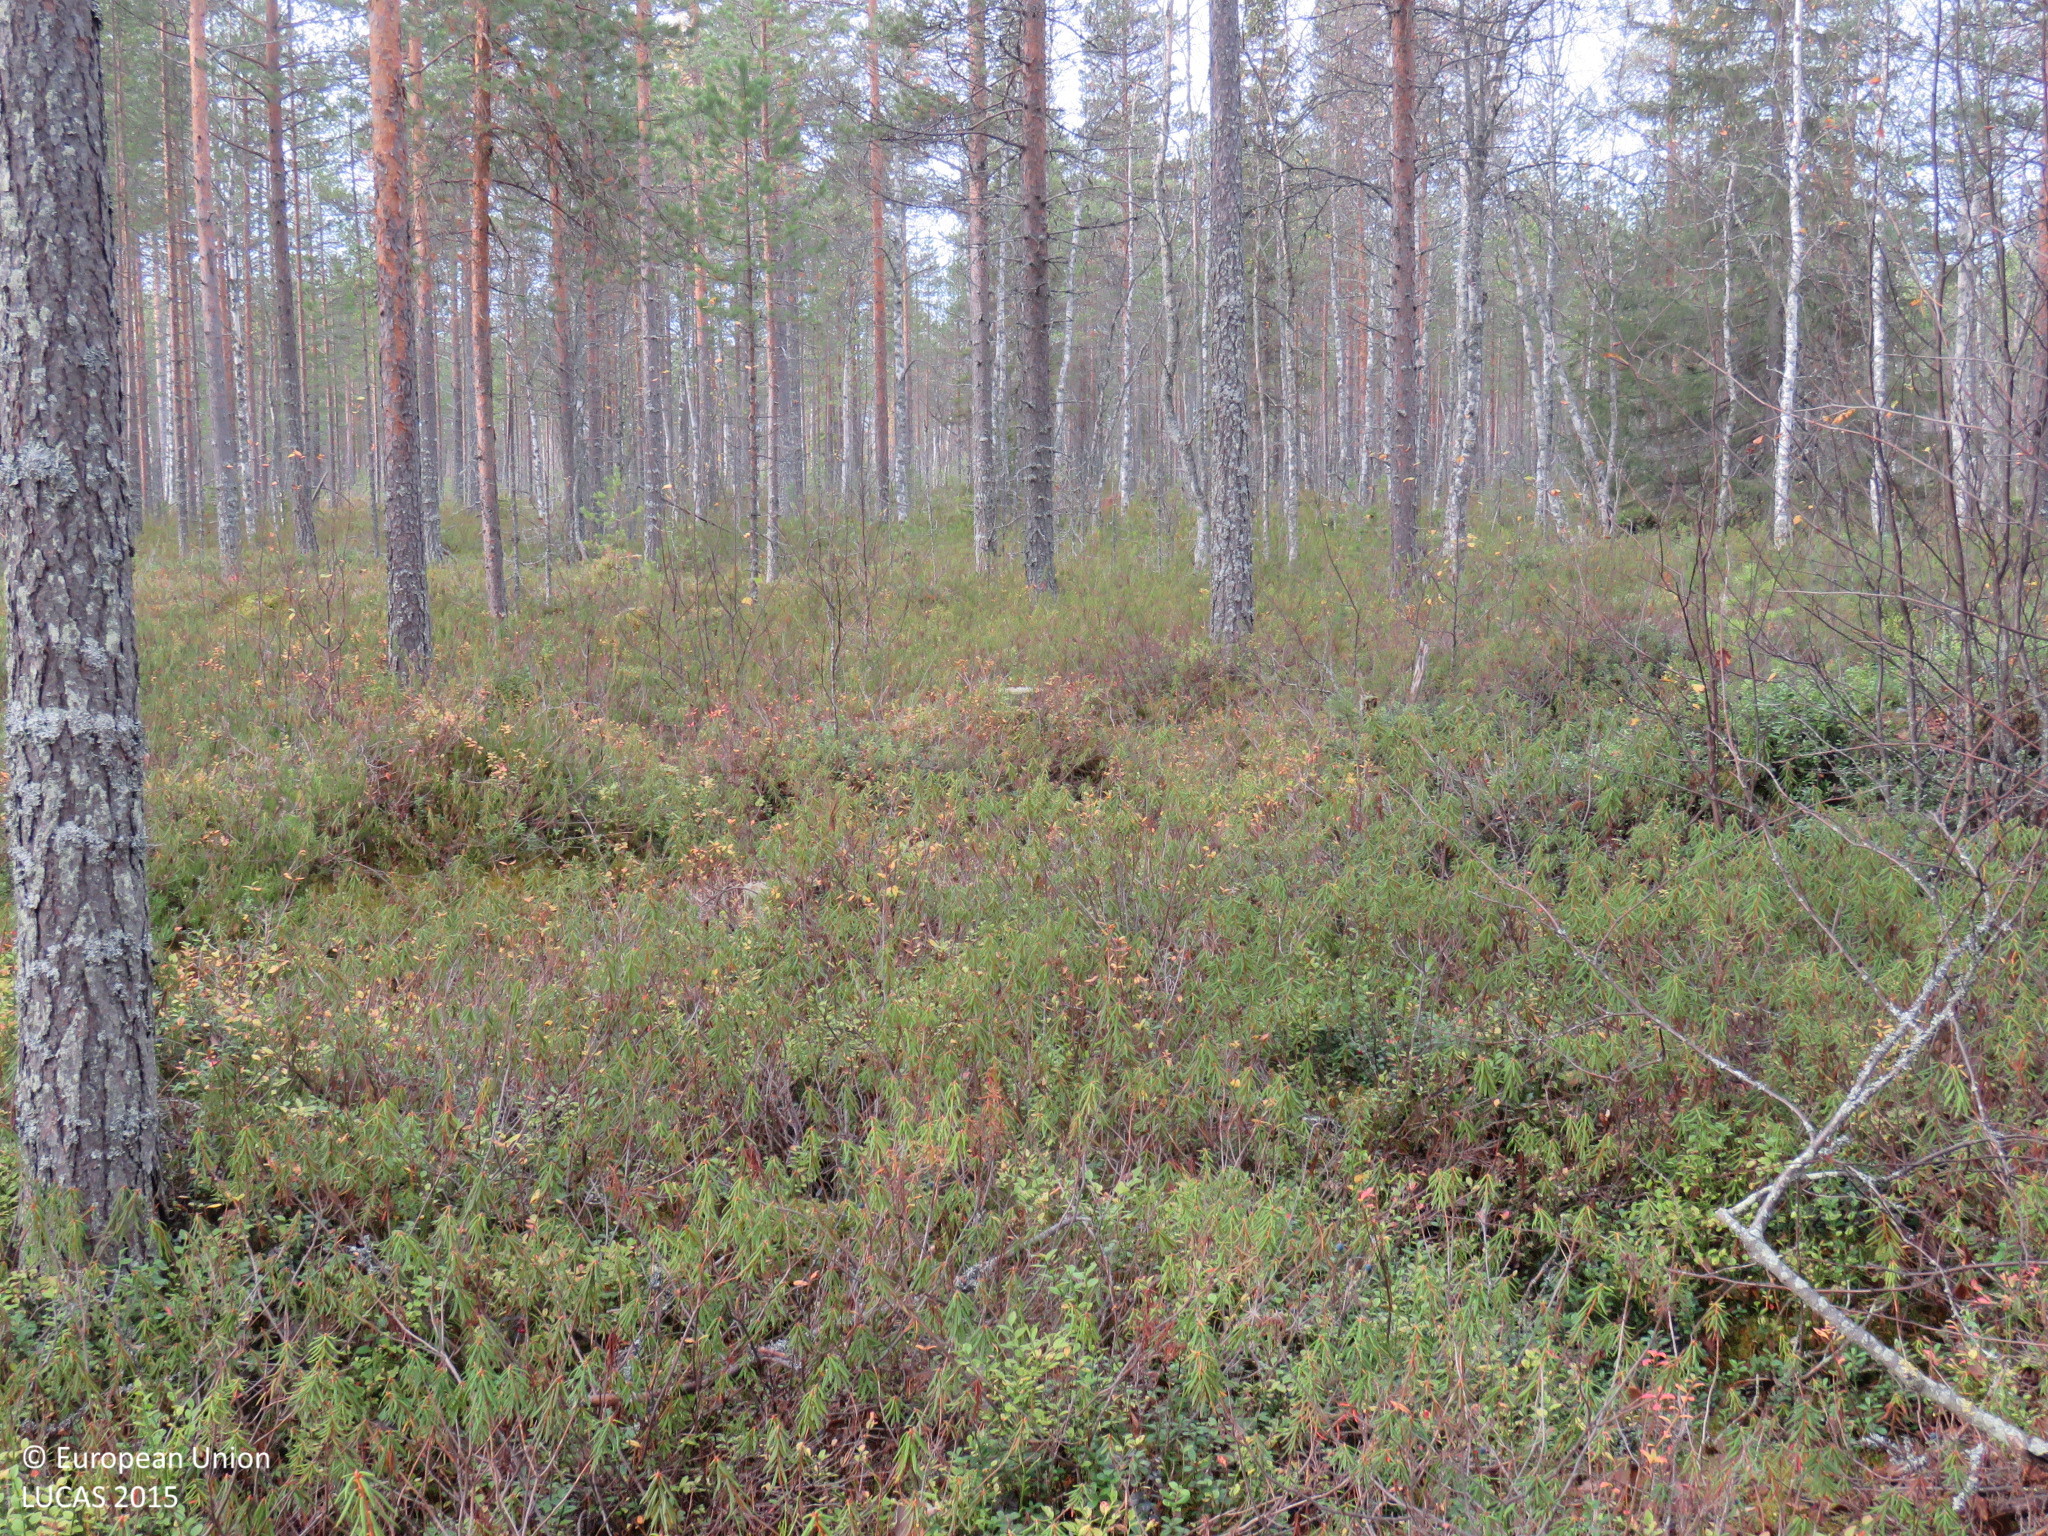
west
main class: Woodland
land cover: Pine dominated coniferous woodland
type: boreal forest
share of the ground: 50 - 75 %
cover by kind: coniferous forest trees 60 %, shrubs 25 %, broadleaved forest trees 10 %, lichens and mosses 5 %
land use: Forestry
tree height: > 5 m
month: September
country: FI
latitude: 64.9656
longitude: 27.2639
